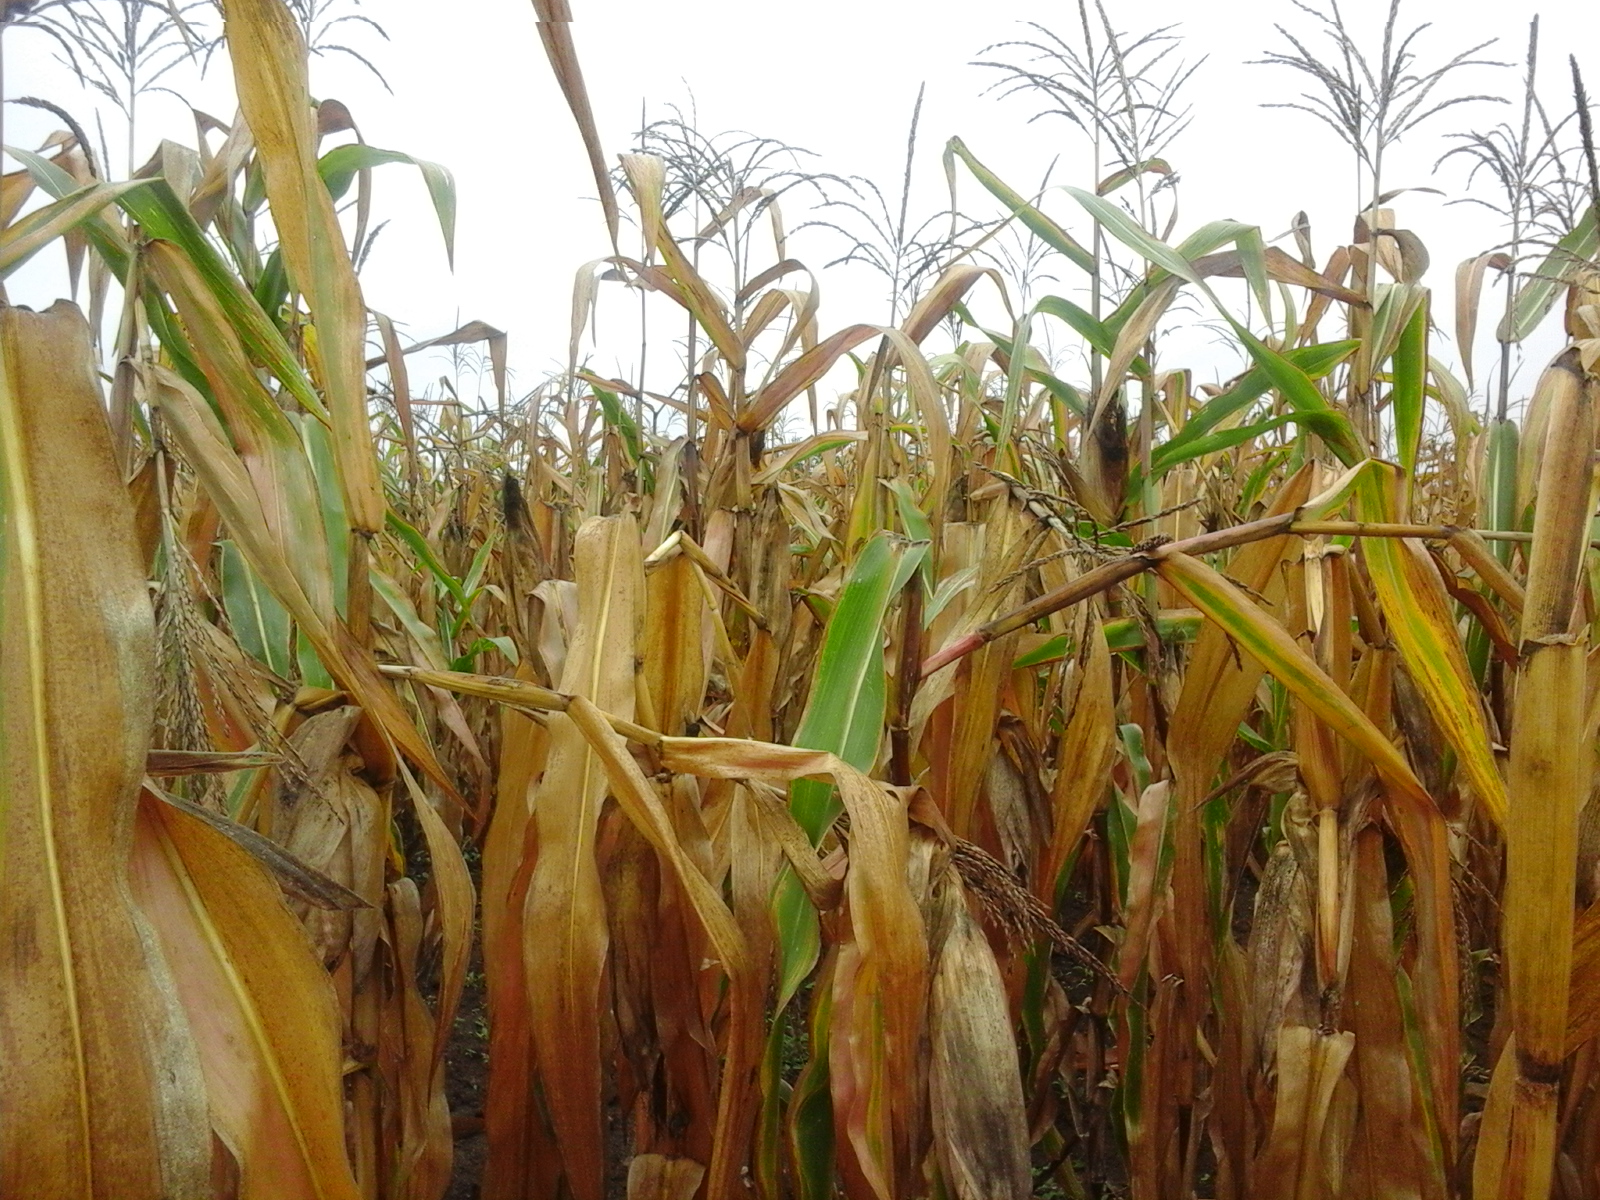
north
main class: Cropland
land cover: Maize
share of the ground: > 75 %
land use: Agriculture (excluding fallow land and kitchen gardens)
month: September
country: RO
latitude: 47.0356
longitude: 21.6895
